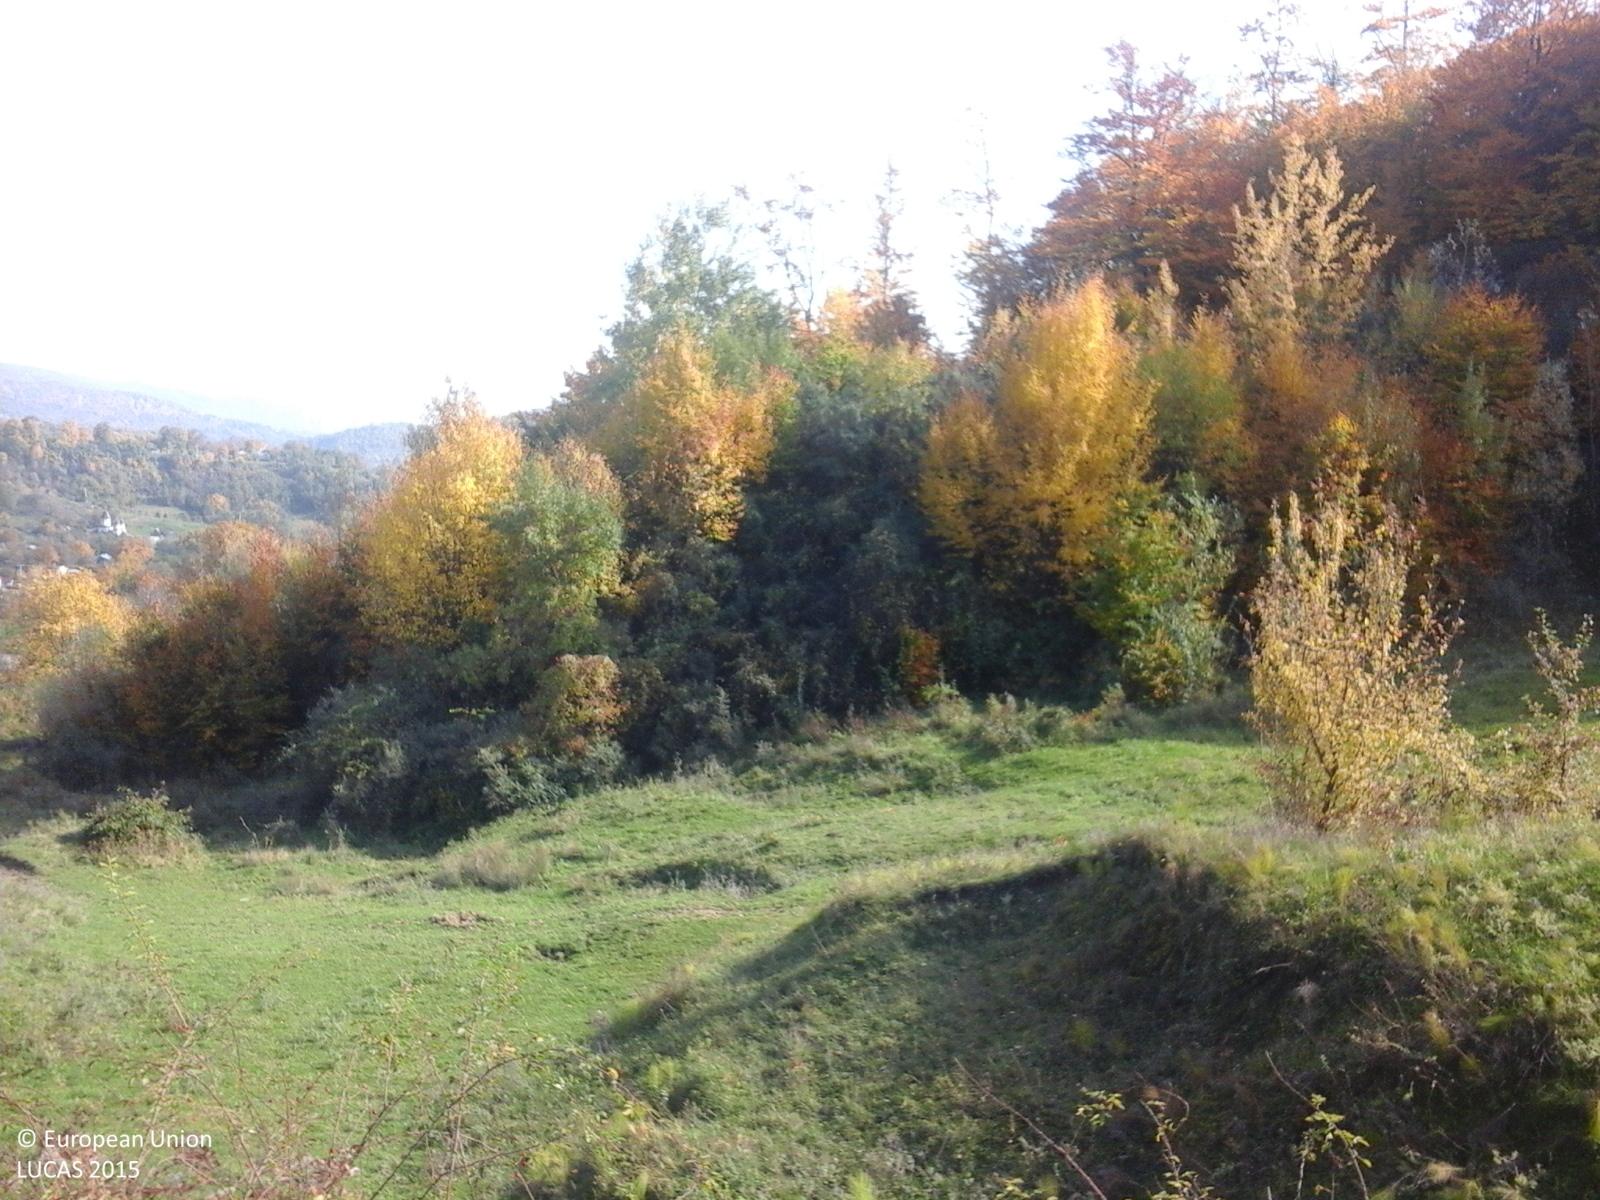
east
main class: Grassland
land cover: Spontaneously vegetated surfaces
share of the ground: > 75 %
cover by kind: herbaceous plants 100 %
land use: Agriculture (excluding fallow land and kitchen gardens)
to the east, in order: Spontaneously vegetated surfaces; Ditches and canals; Spontaneously vegetated surfaces; Broadleaved woodland; Tracks; Grassland without tree/shrub cover; Artificial constructions in urban areas; Grassland without tree/shrub cover
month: October
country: RO
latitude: 45.7632
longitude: 26.9185
